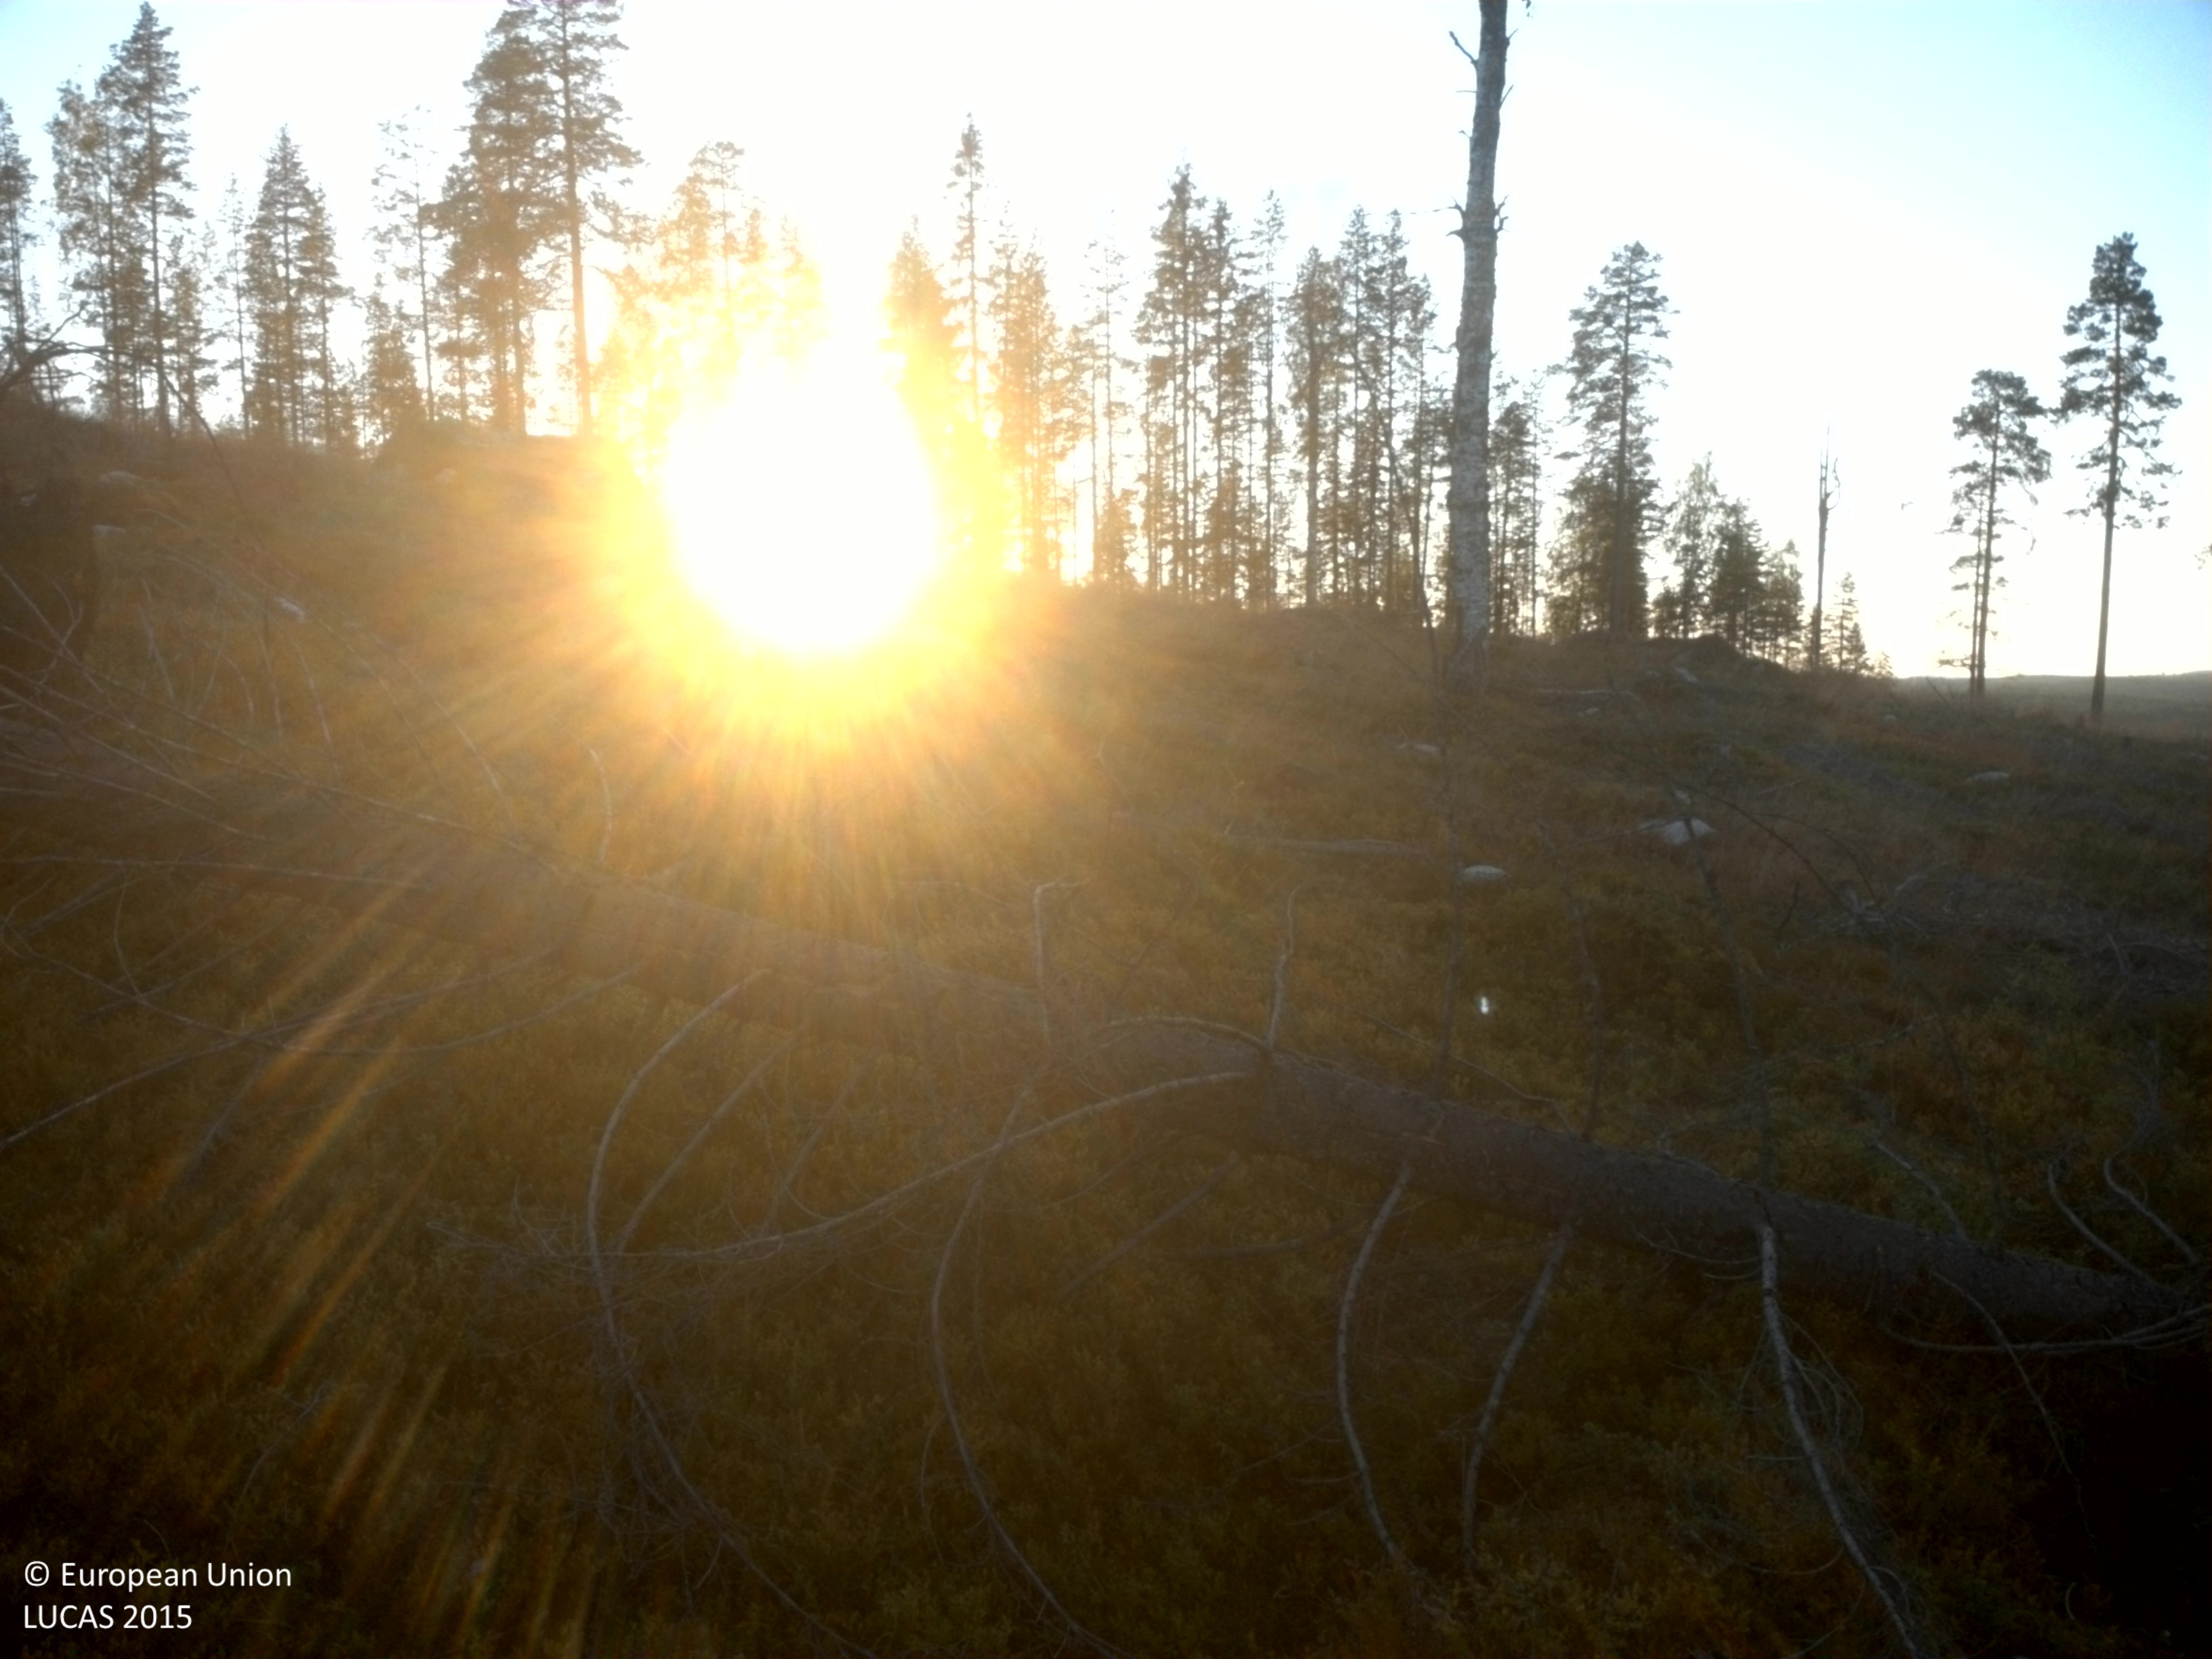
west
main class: Woodland
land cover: Pine dominated coniferous woodland
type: boreal forest
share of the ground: 10 - 25 %
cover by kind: shrubs 80 %, coniferous forest trees 20 %
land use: Forestry
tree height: > 5 m
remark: Clear cut
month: August
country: SE
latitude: 64.6593
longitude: 18.8676
